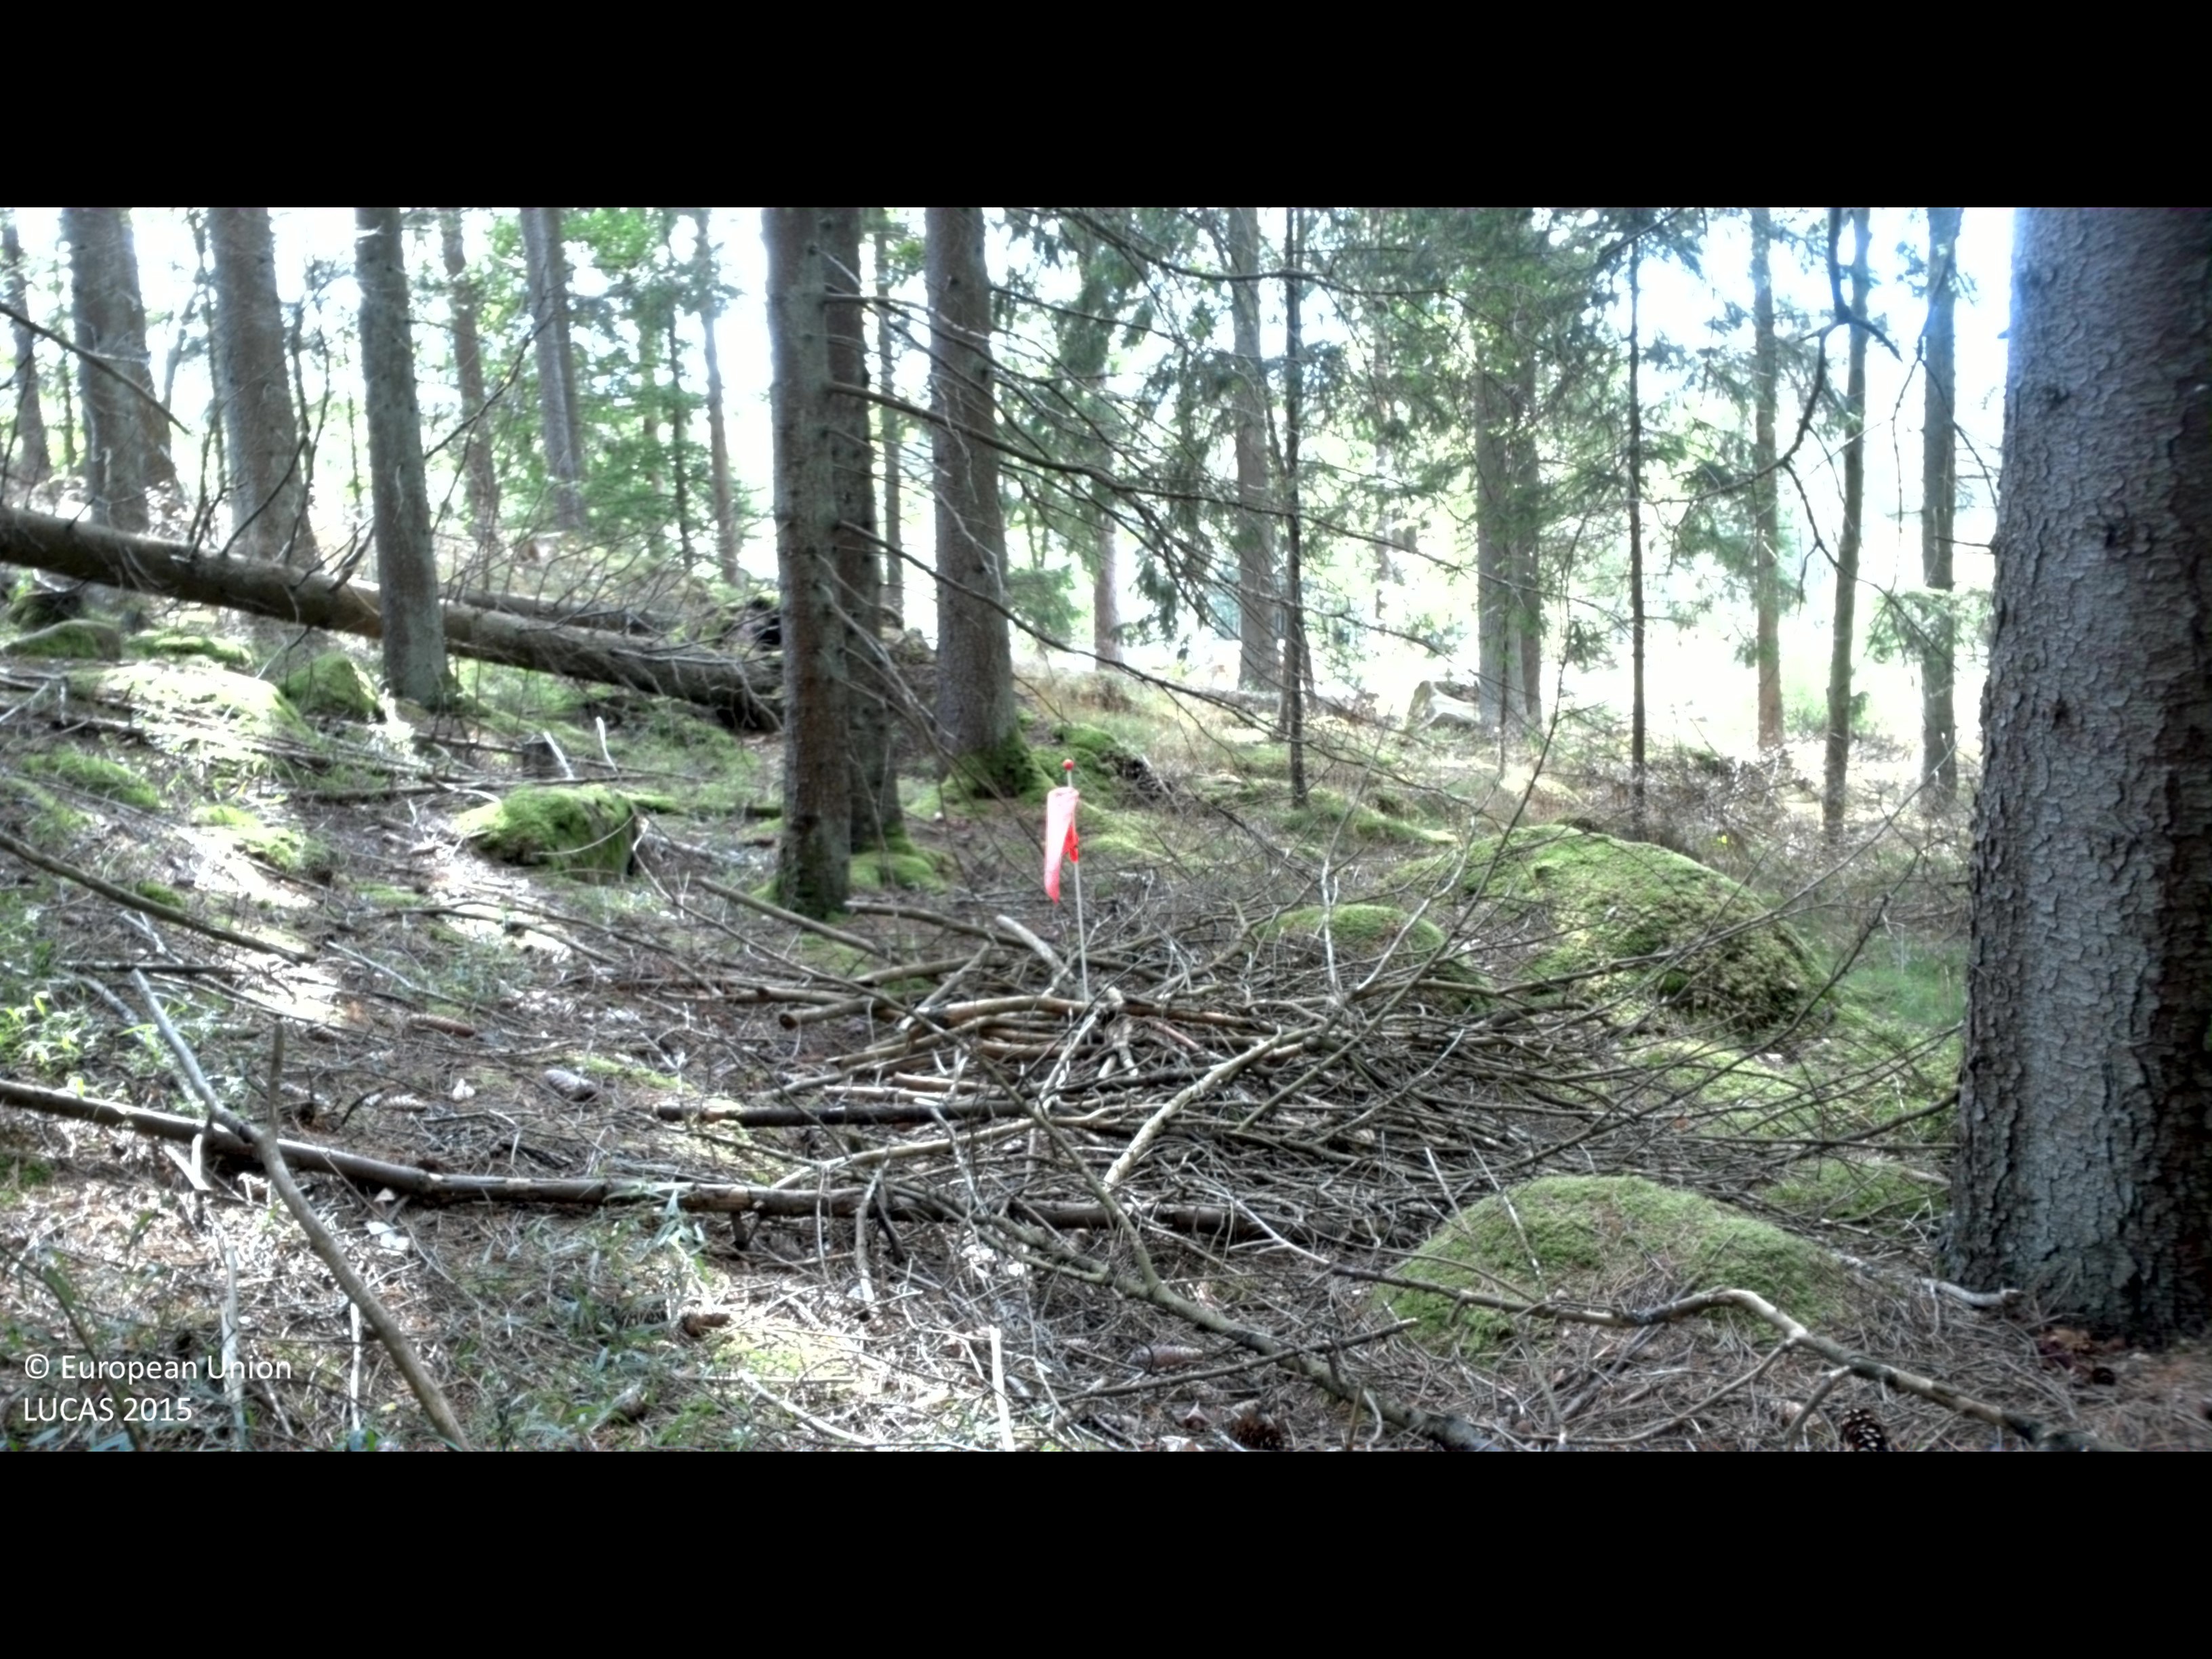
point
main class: Woodland
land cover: Spruce dominated coniferous woodland
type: boreal forest
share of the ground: > 75 %
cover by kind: coniferous forest trees 75 %, lichens and mosses 15 %
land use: Forestry
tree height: > 5 m
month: August
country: SE
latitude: 56.3492
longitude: 14.3179
